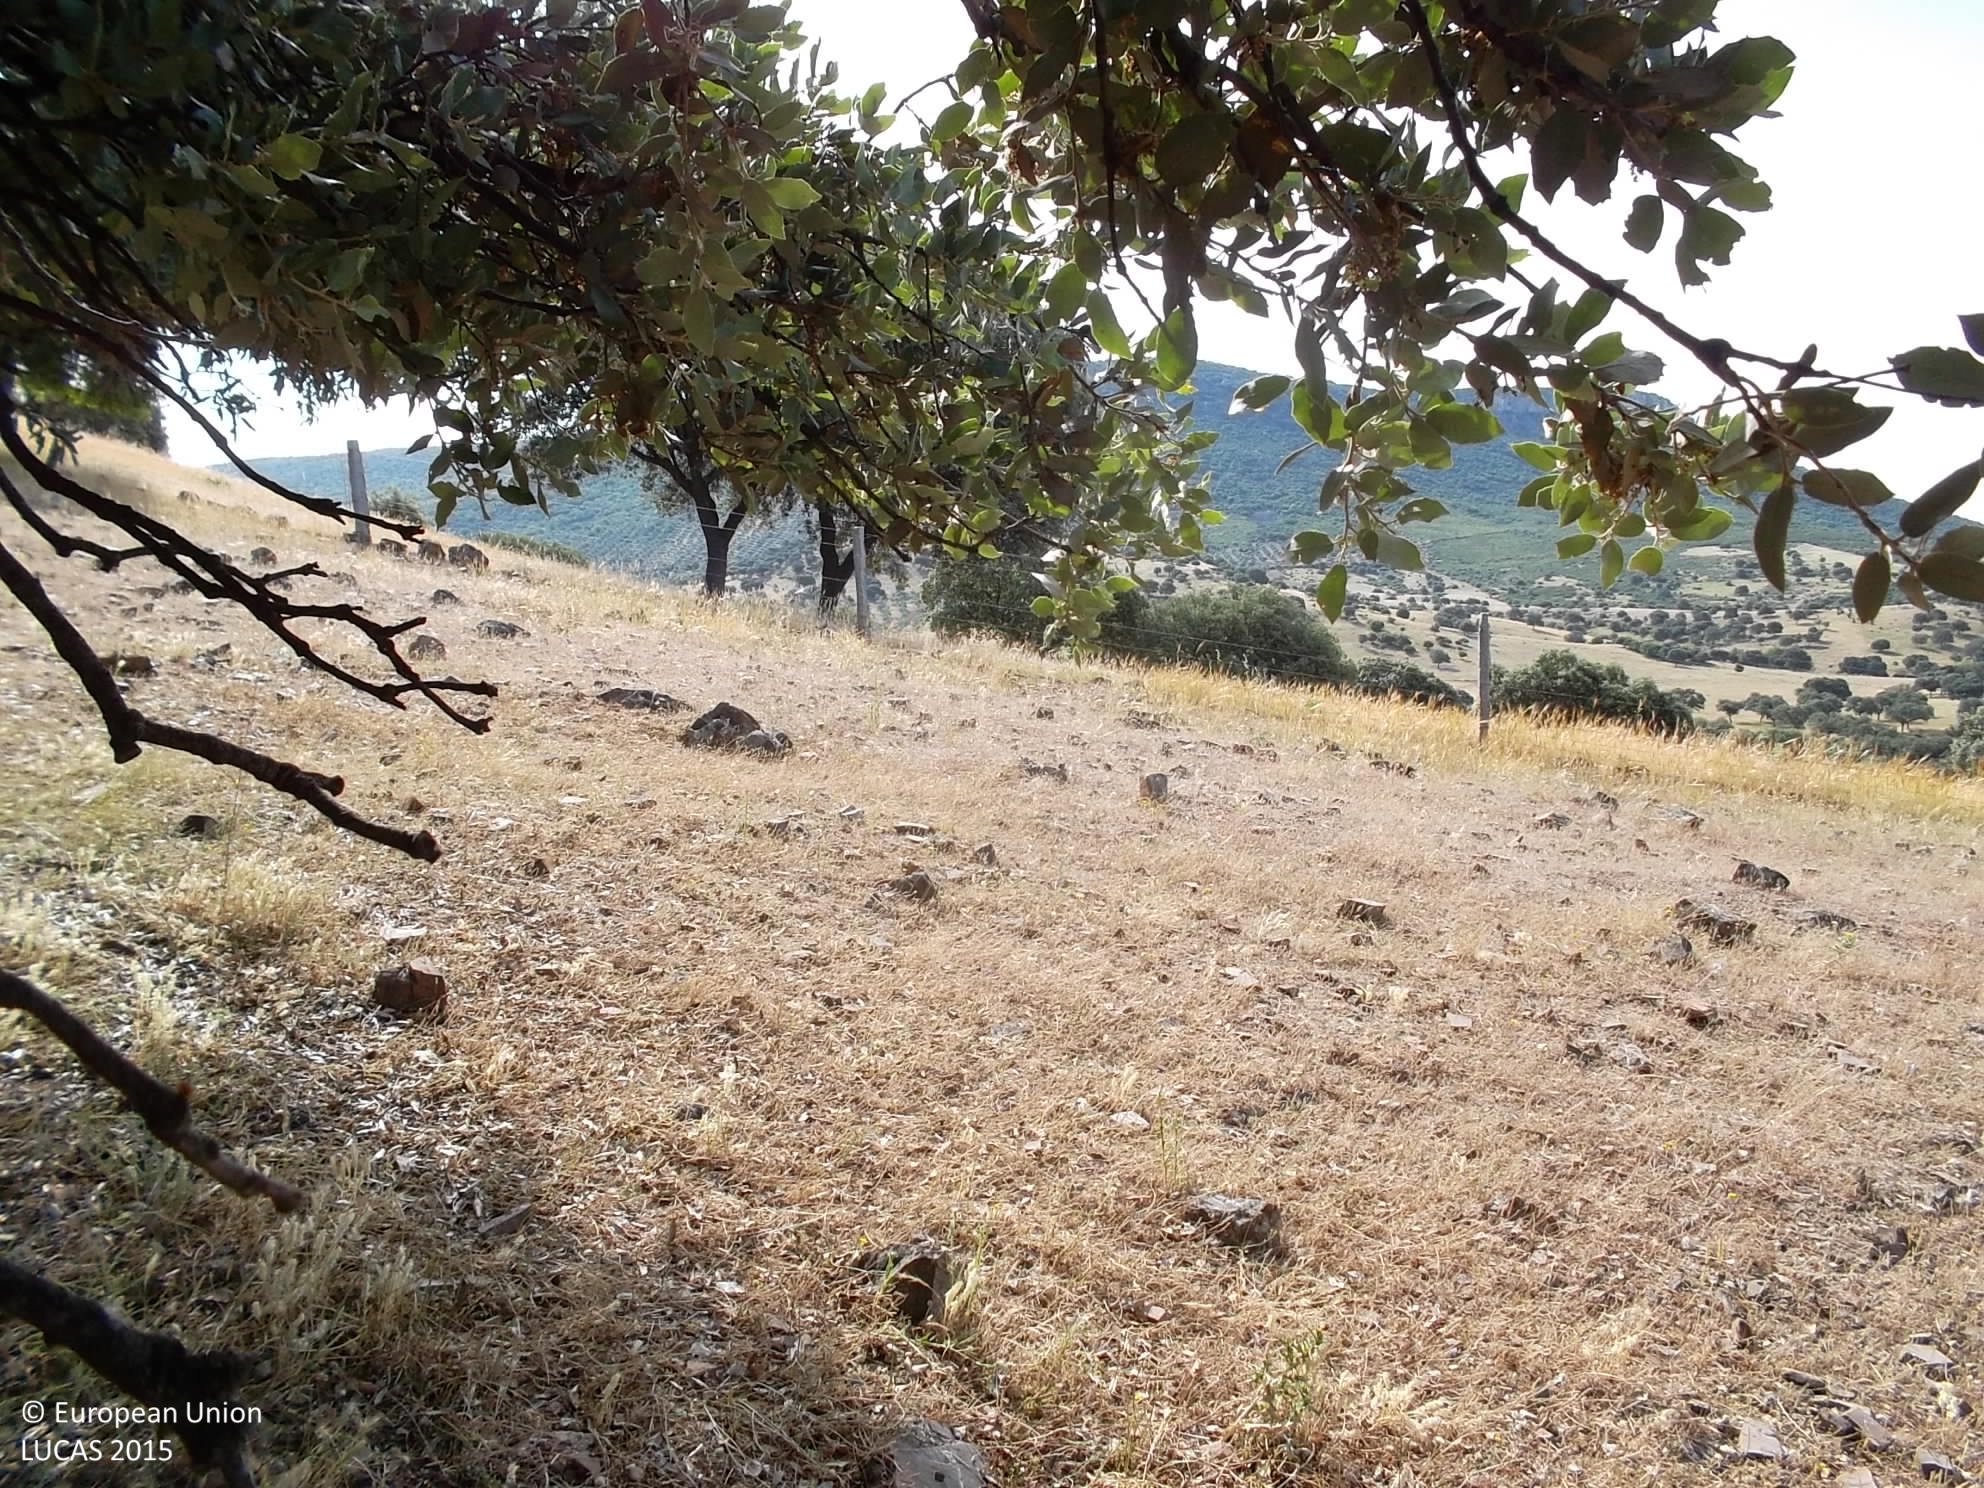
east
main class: Woodland
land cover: Broadleaved woodland
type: broadleaved evergreen forest
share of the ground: 25 - 50 %
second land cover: Spontaneously vegetated surfaces
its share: > 75 %
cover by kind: herbaceous plants 60 %, broadleaved forest trees 40 %
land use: Forestry
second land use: Agriculture (excluding fallow land and kitchen gardens)
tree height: > 5 m
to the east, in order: Broadleaved woodland; Spontaneously vegetated surfaces; Fences; Broadleaved woodland; Grassland with sparse tree/shrub cover; Broadleaved woodland; Grassland with sparse tree/shrub cover
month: May
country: ES
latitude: 38.6007
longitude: -4.7110
